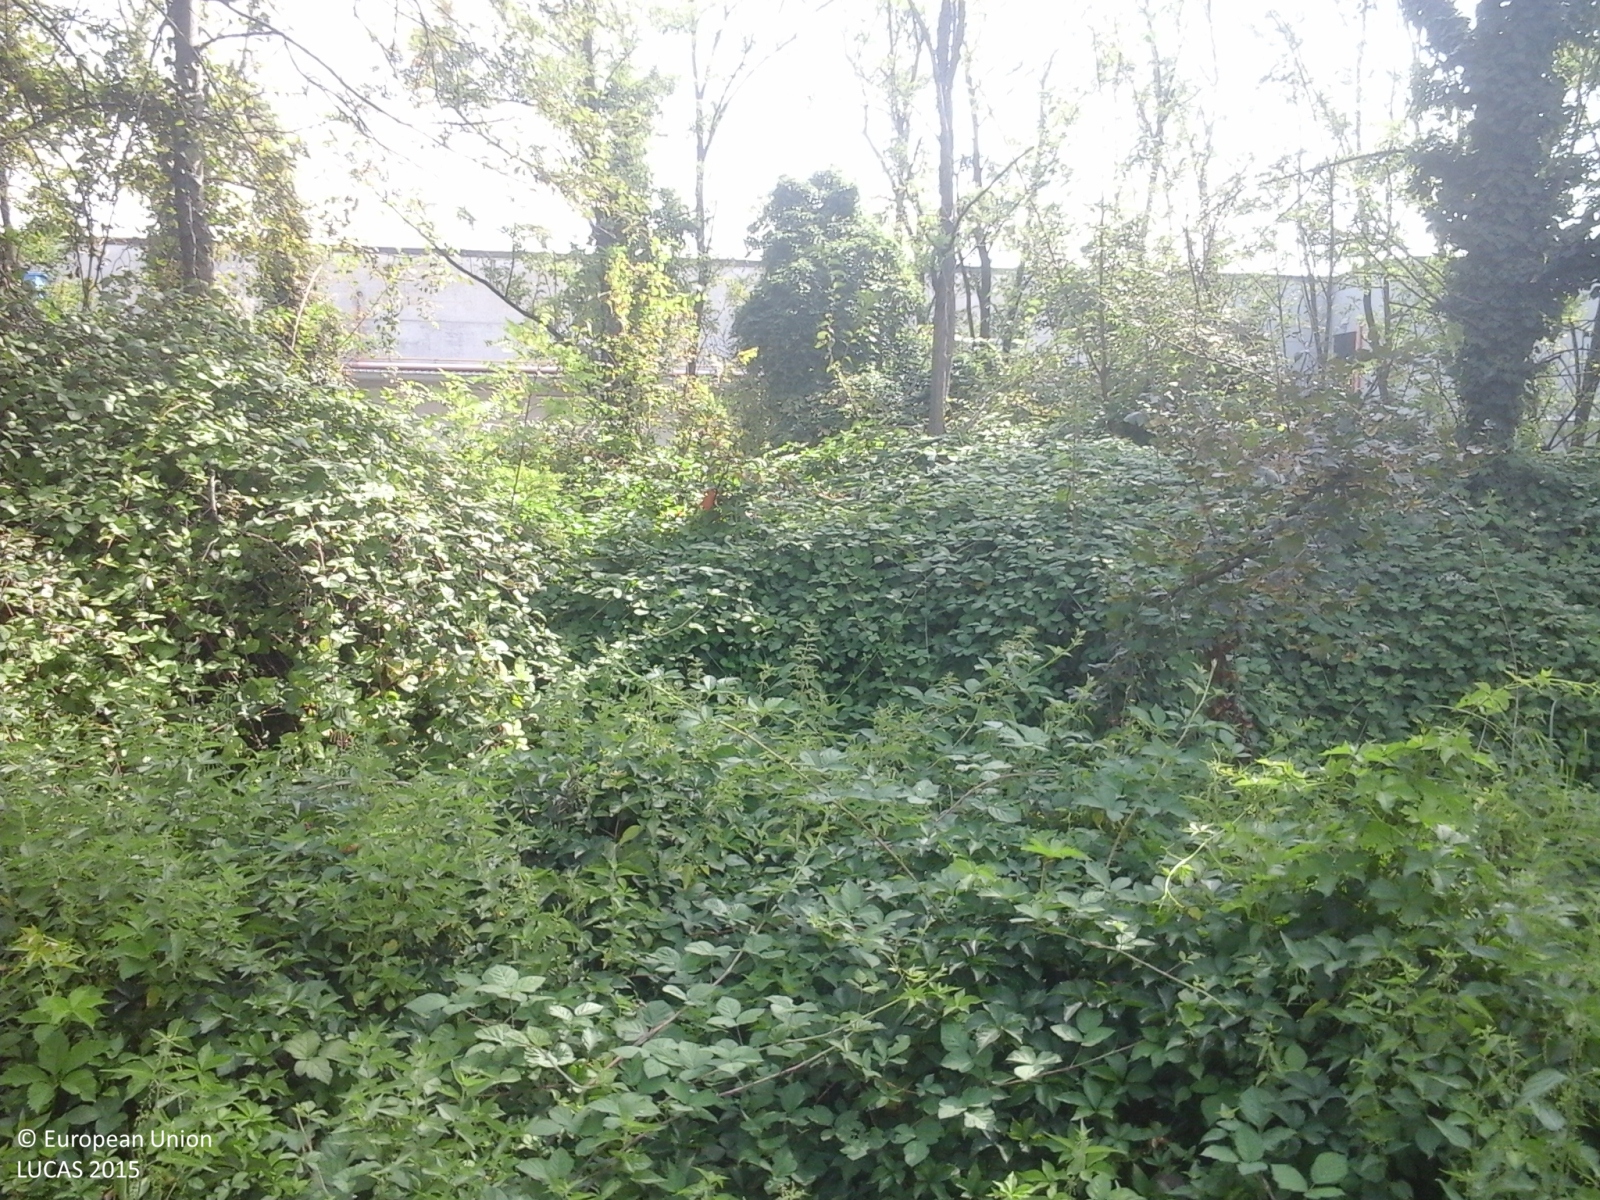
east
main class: Grassland
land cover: Spontaneously vegetated surfaces
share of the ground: > 75 %
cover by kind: herbaceous plants 95 %, shrubs 5 %
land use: Semi-natural and natural areas not in use
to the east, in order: Spontaneously vegetated surfaces; Ditches and canals; Abandoned hedges; Tracks; Inland fresh running water; Abandoned hedges; Artificial constructions in urban areas
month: September
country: IT
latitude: 45.4845
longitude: 9.3742
